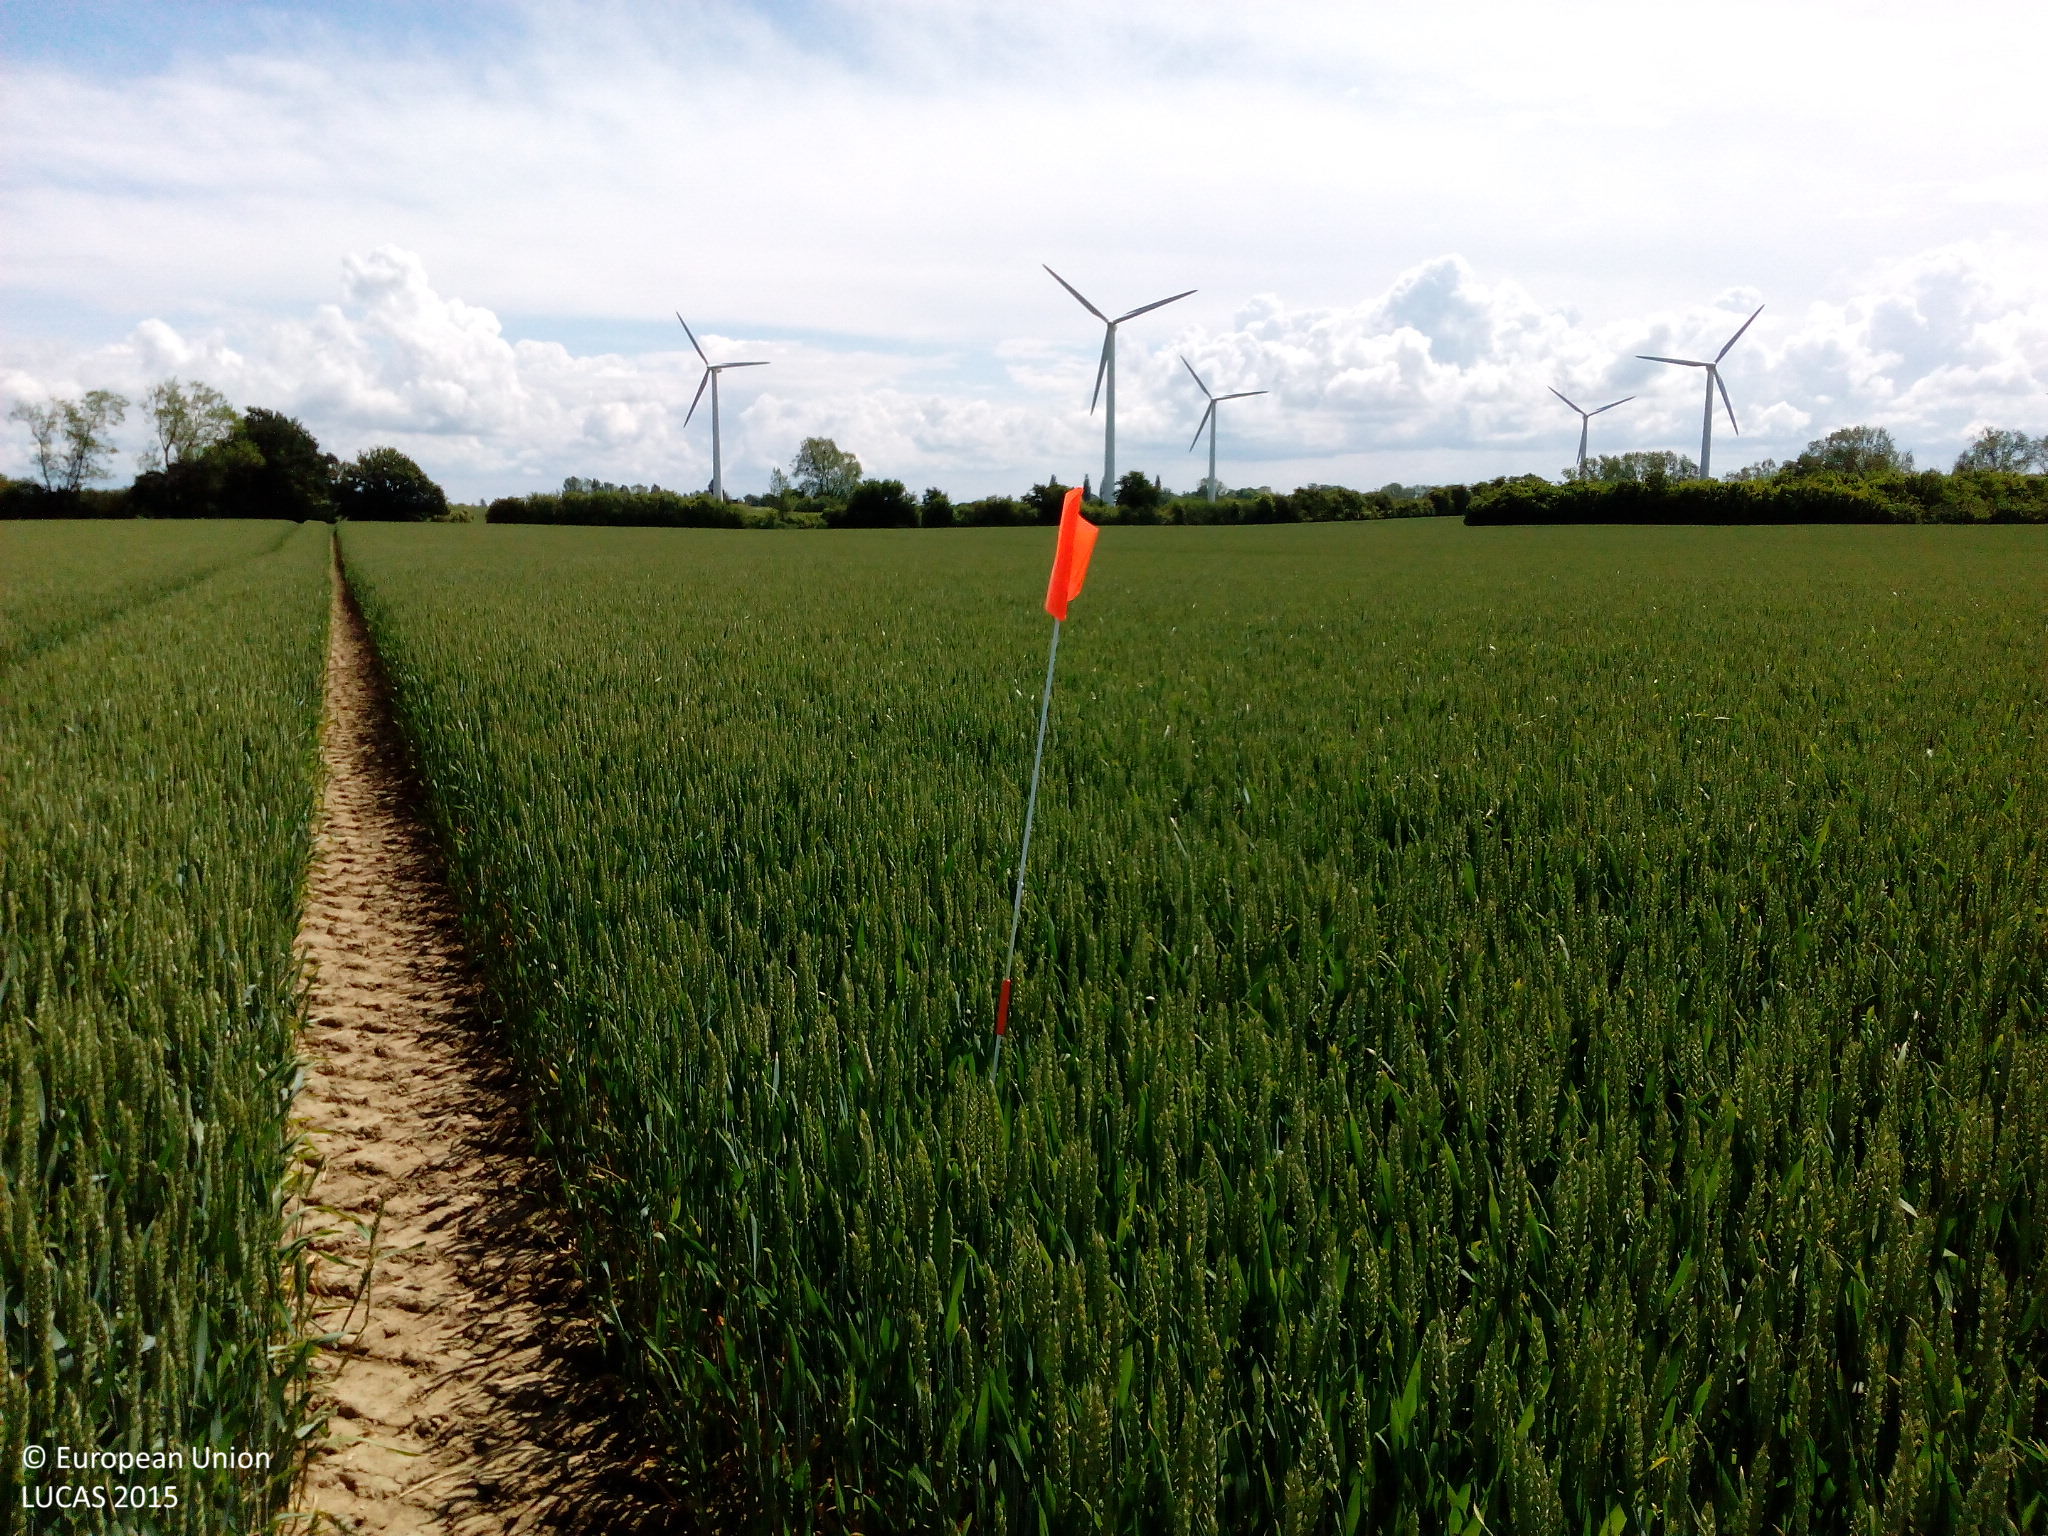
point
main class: Cropland
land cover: Common wheat
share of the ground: > 75 %
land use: Agriculture (excluding fallow land and kitchen gardens)
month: June
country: DK
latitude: 54.8122
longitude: 11.5394
